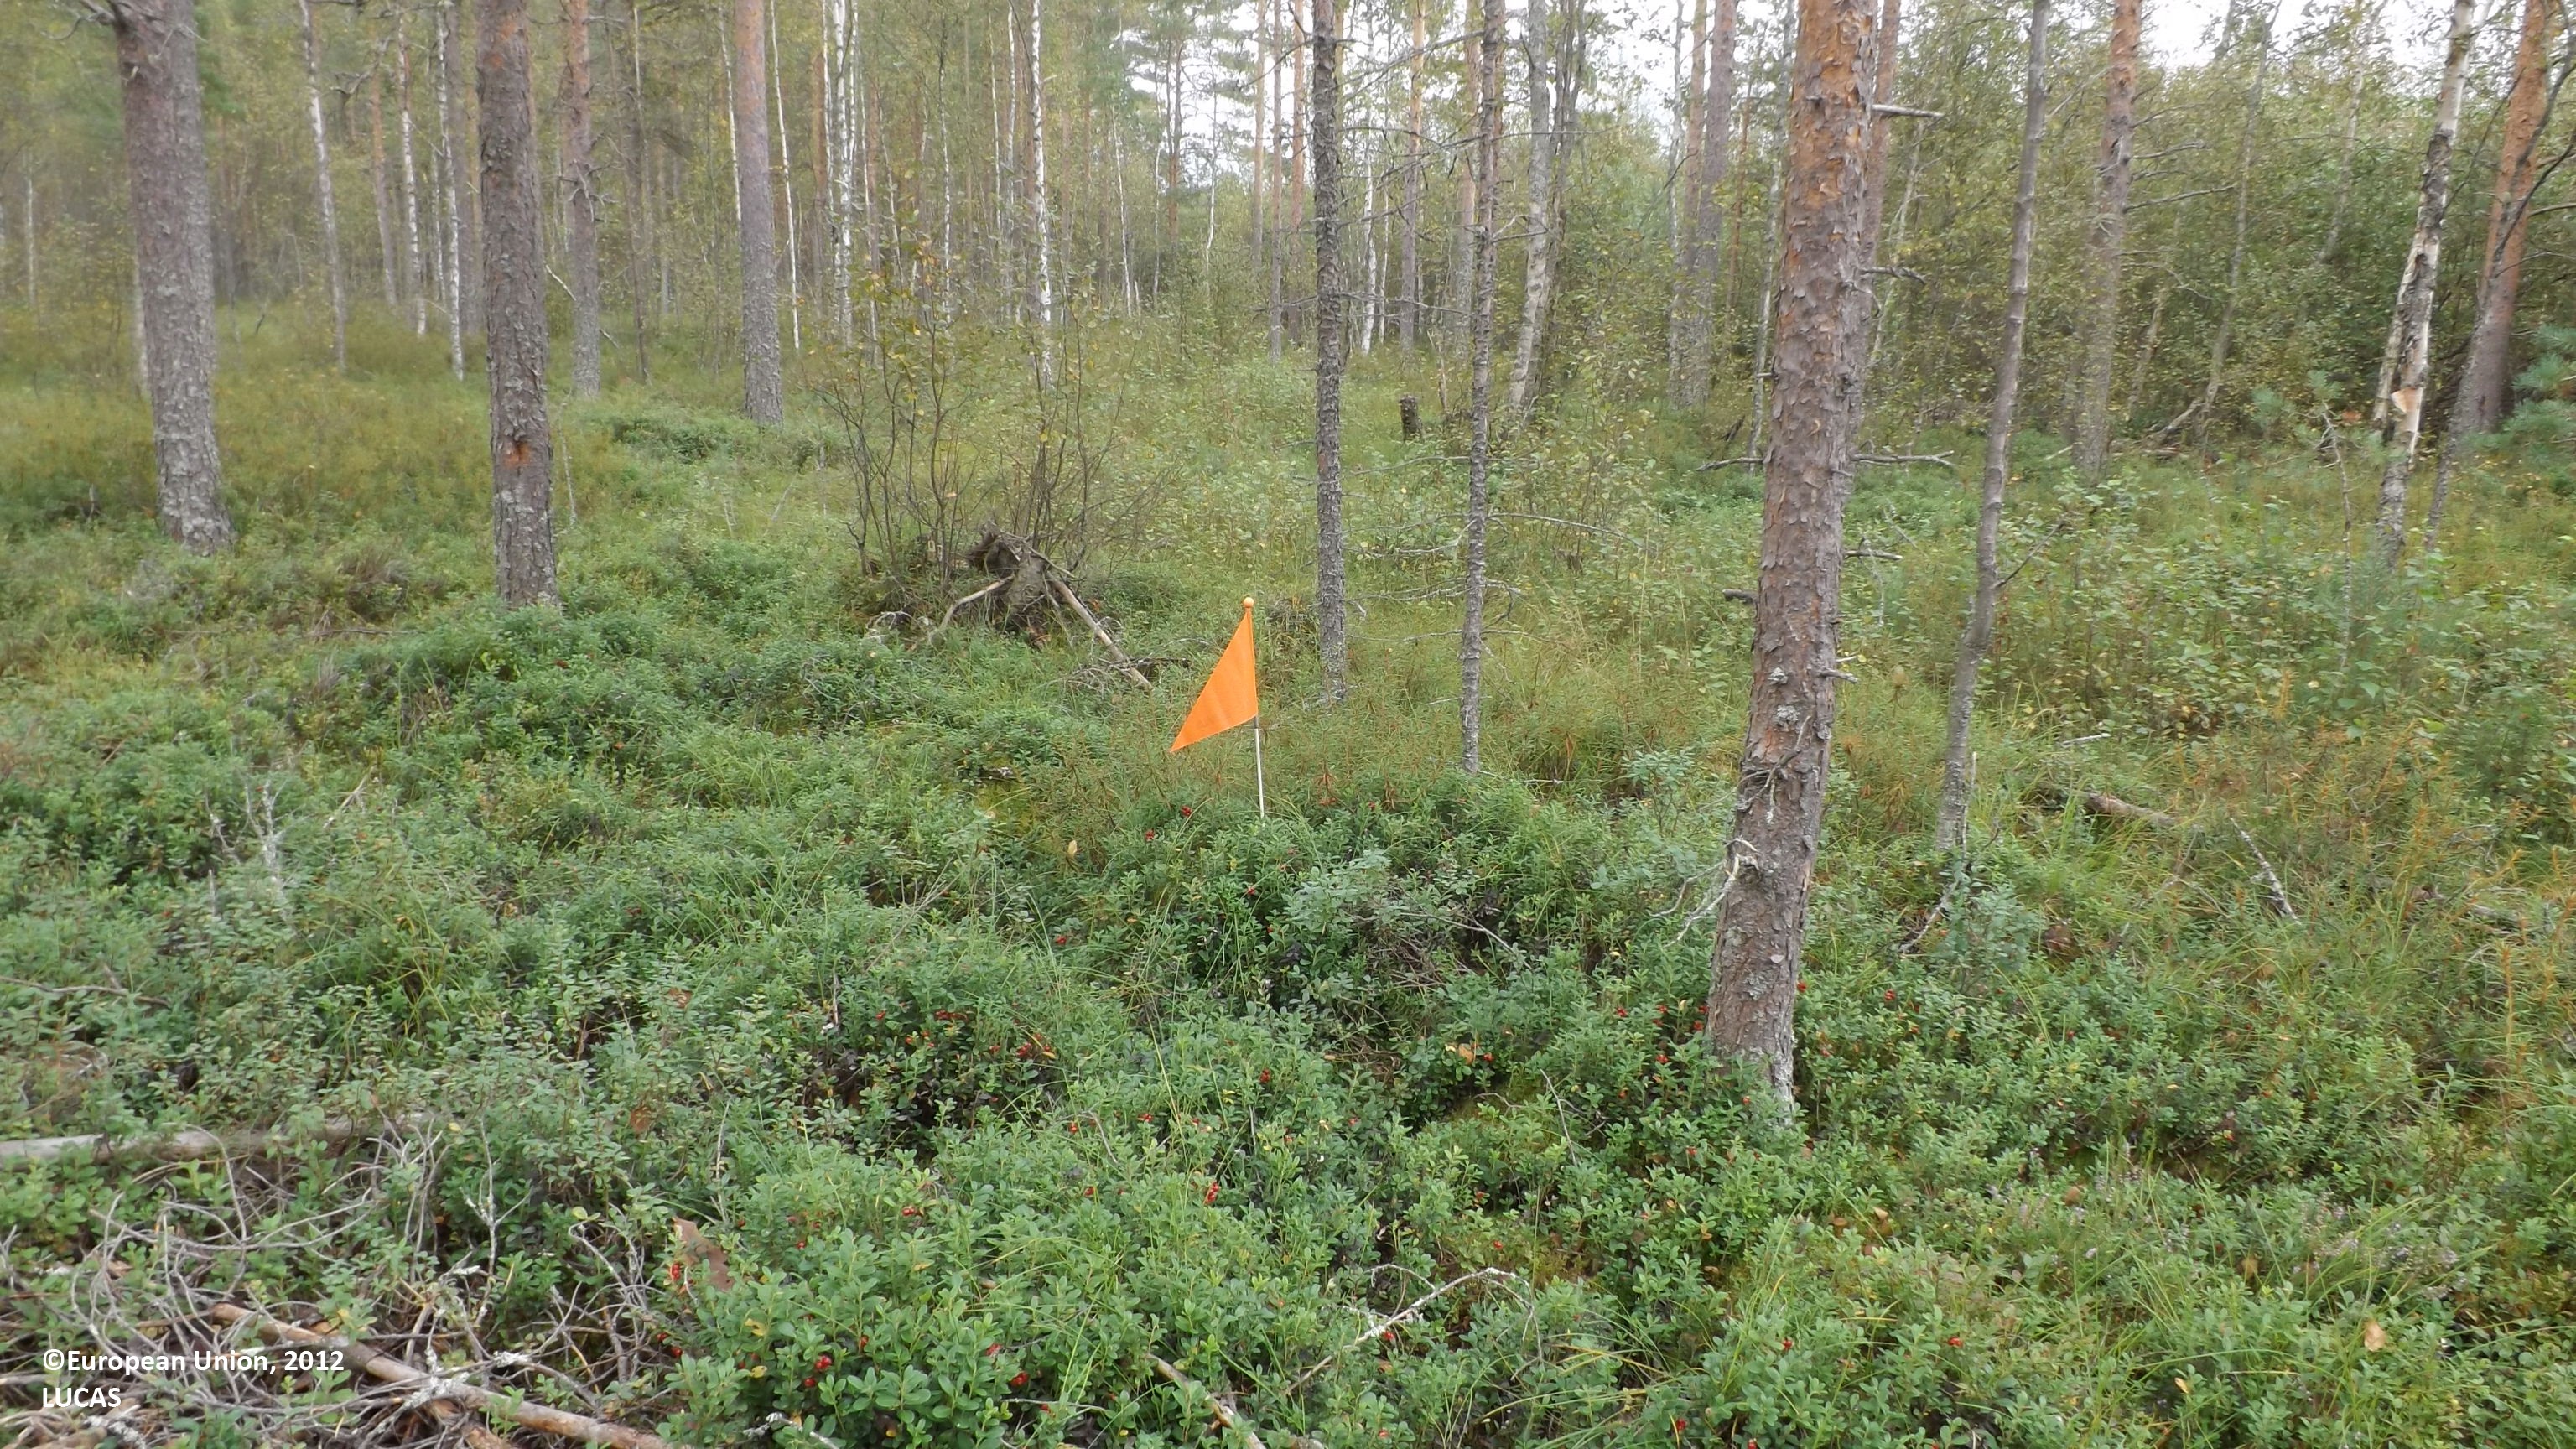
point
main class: Woodland
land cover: Pine dominated mixed woodland
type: boreal forest
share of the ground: 50 - 75 %
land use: Forestry
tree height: > 5 m
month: August
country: FI
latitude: 63.9005
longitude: 23.8153
